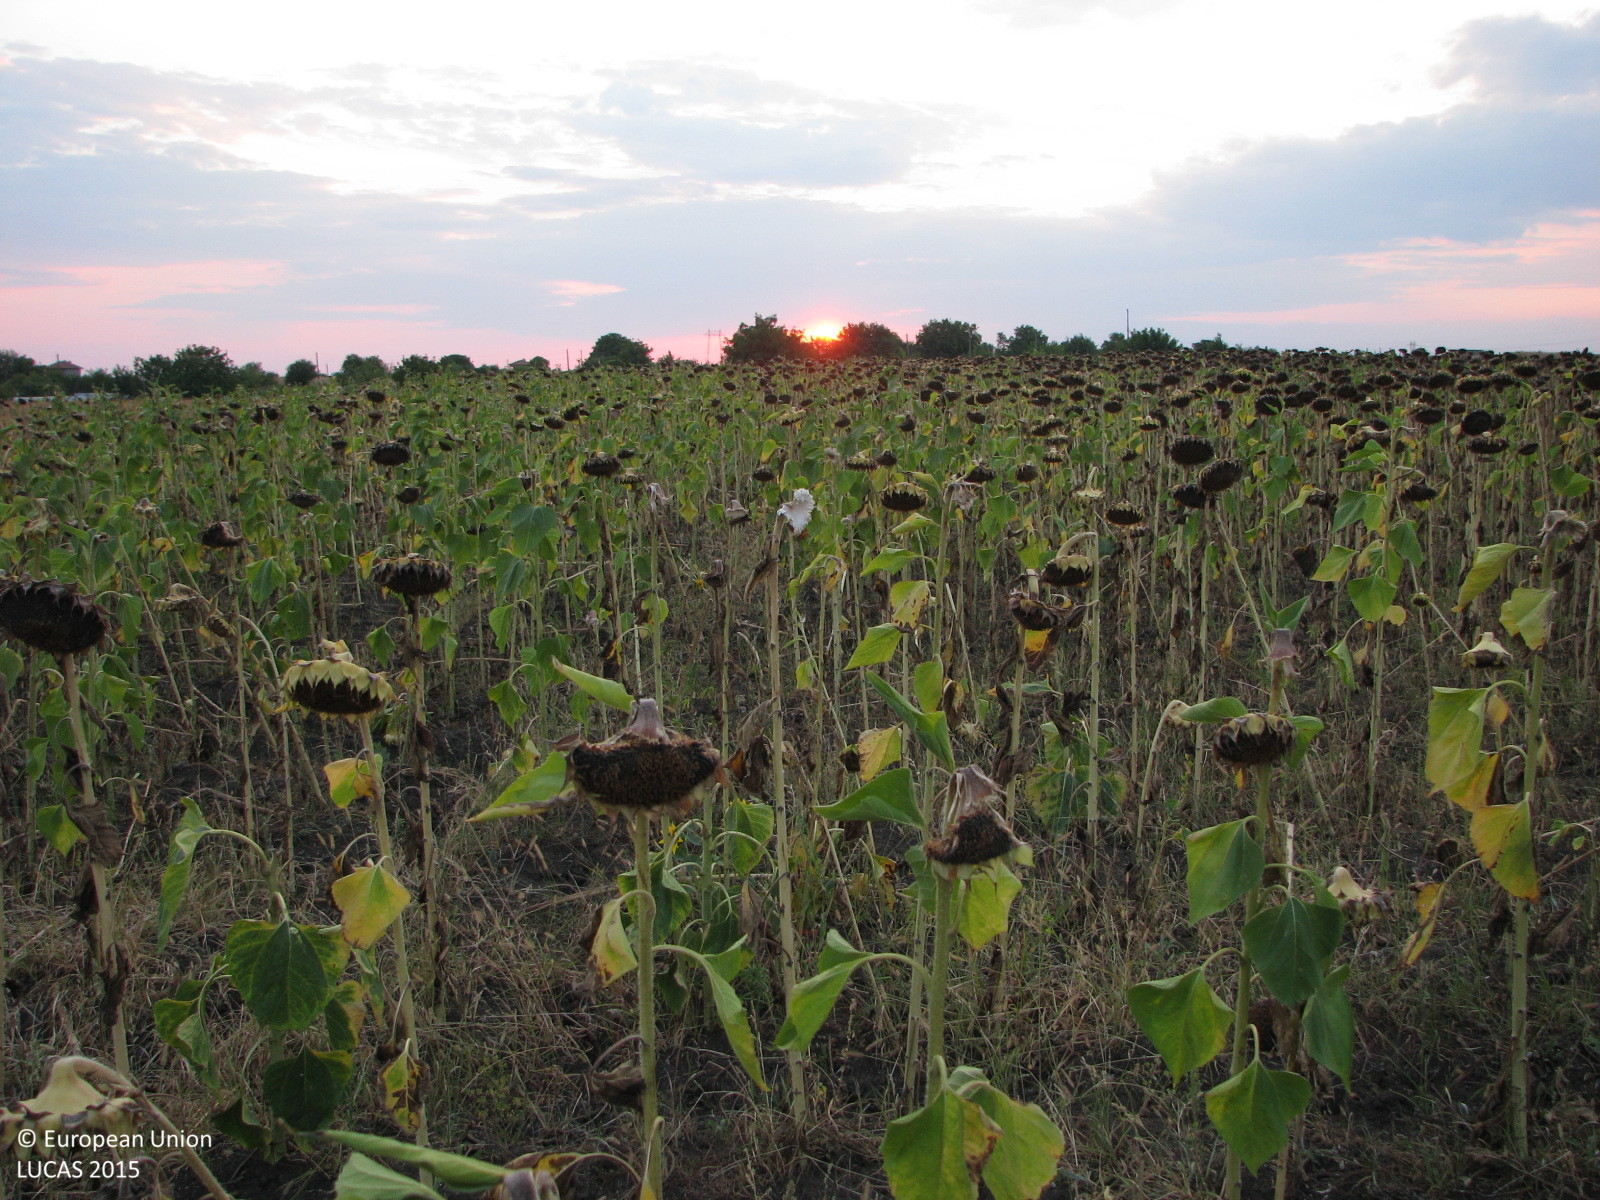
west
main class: Cropland
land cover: Sunflower
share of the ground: > 75 %
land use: Agriculture (excluding fallow land and kitchen gardens)
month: August
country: BG
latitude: 42.4730
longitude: 26.5750
